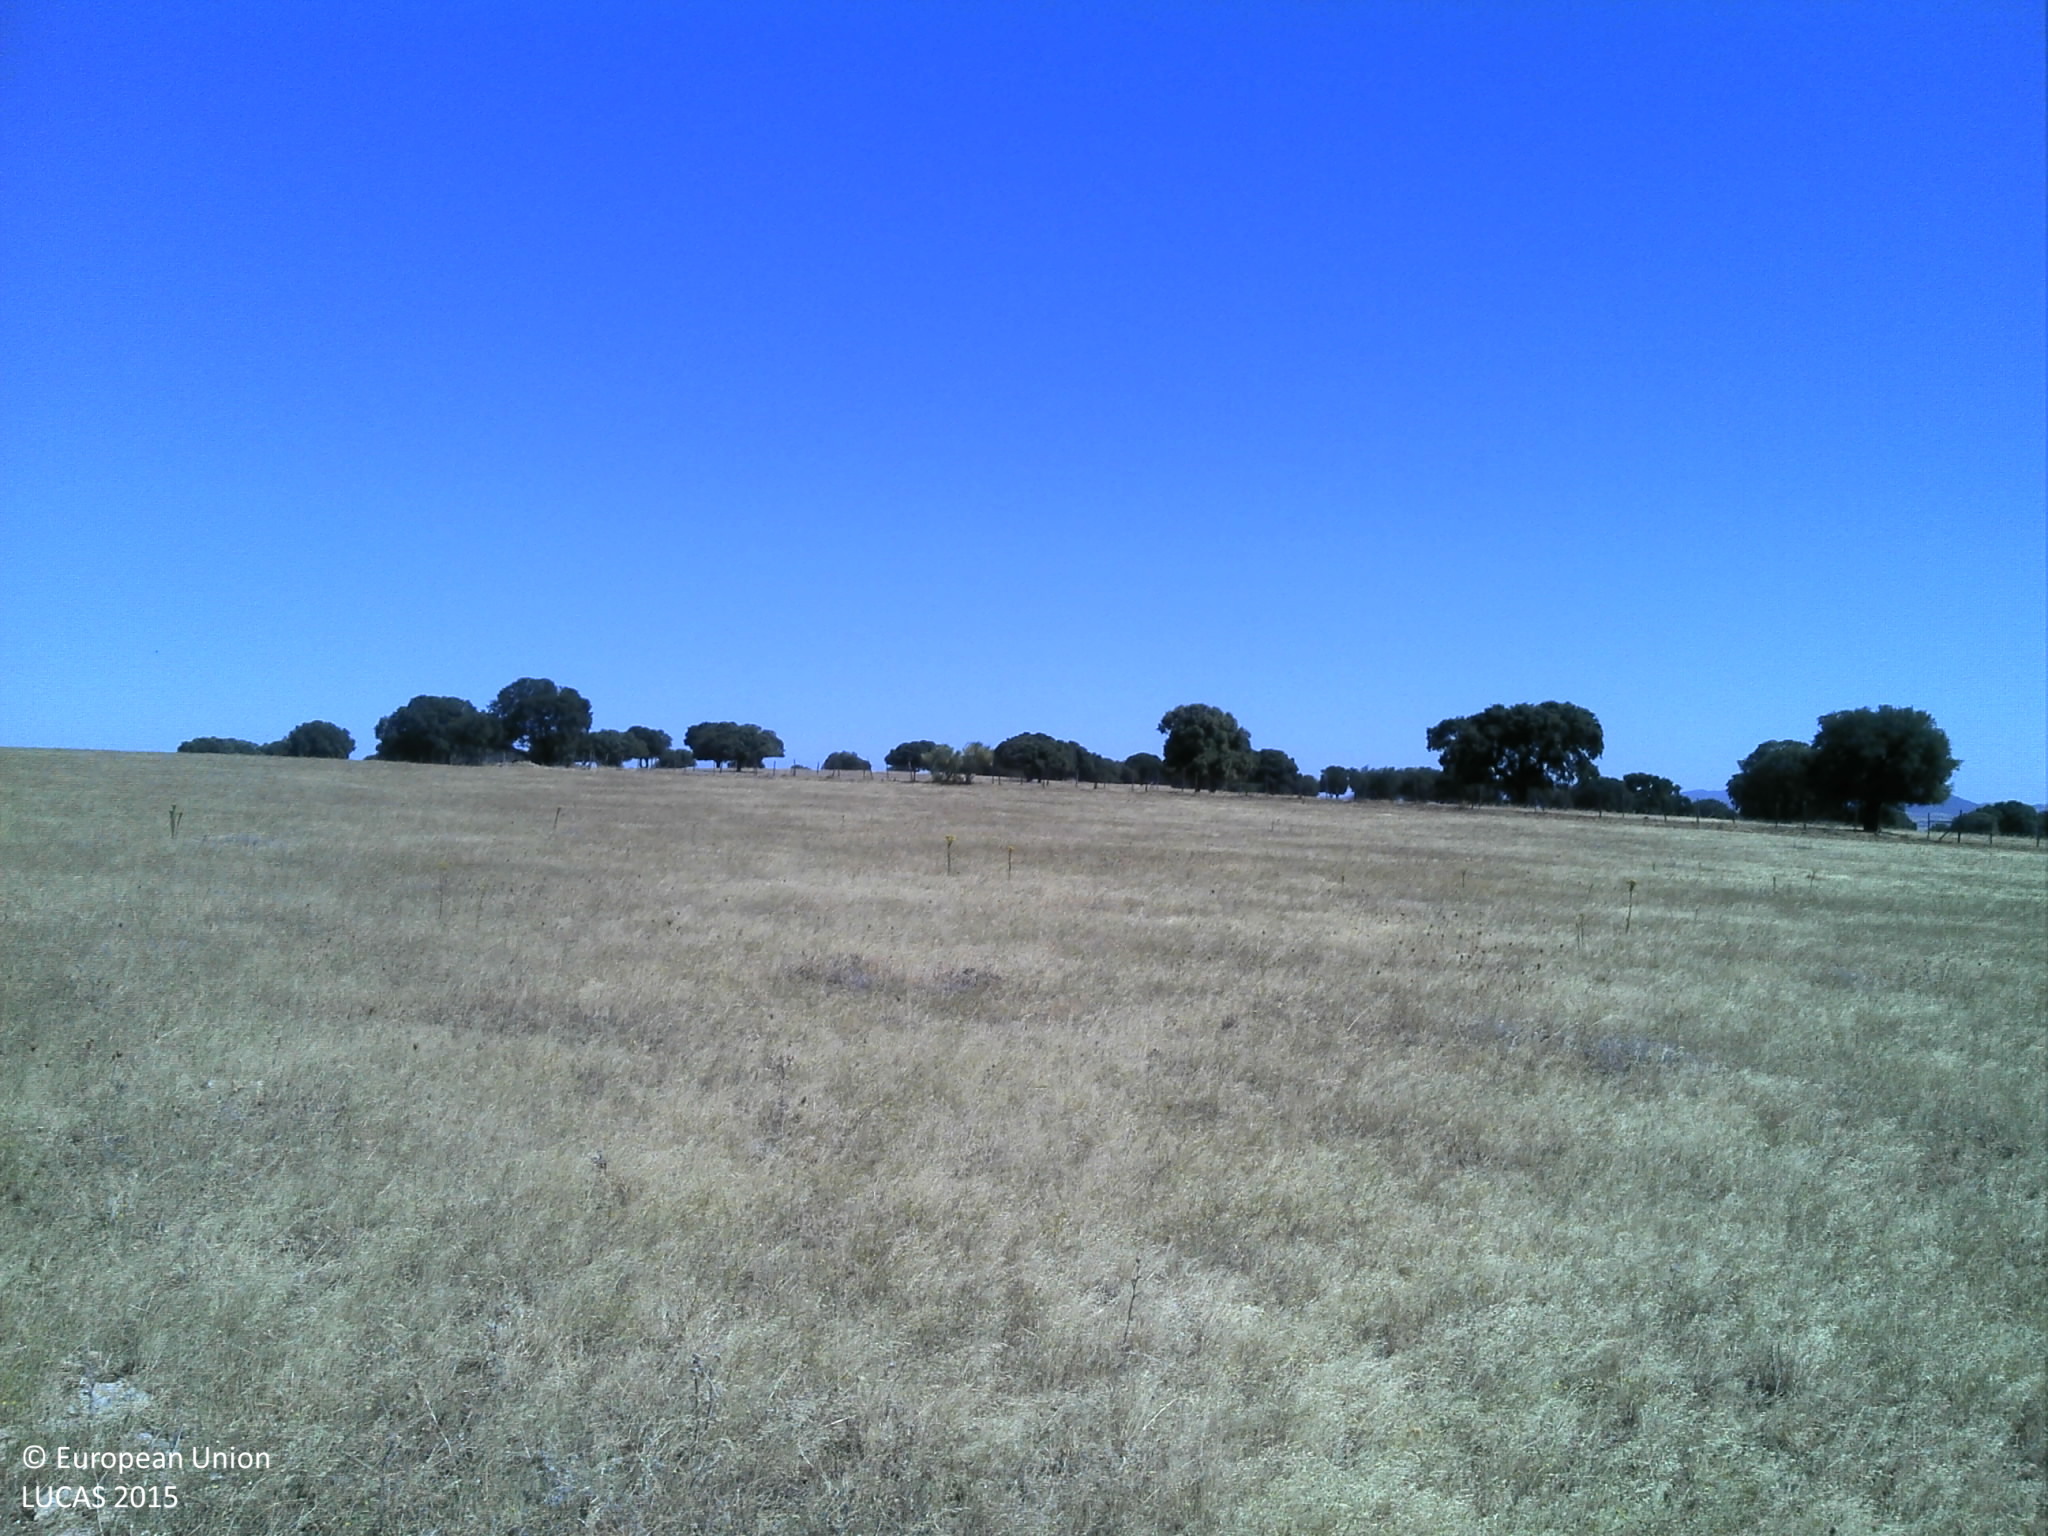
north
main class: Grassland
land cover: Spontaneously vegetated surfaces
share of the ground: 10 - 25 %
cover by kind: unconsolidated bare surface 85 %, herbaceous plants 15 %
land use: Fallow land
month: July
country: PT
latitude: 39.0534
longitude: -7.0732
